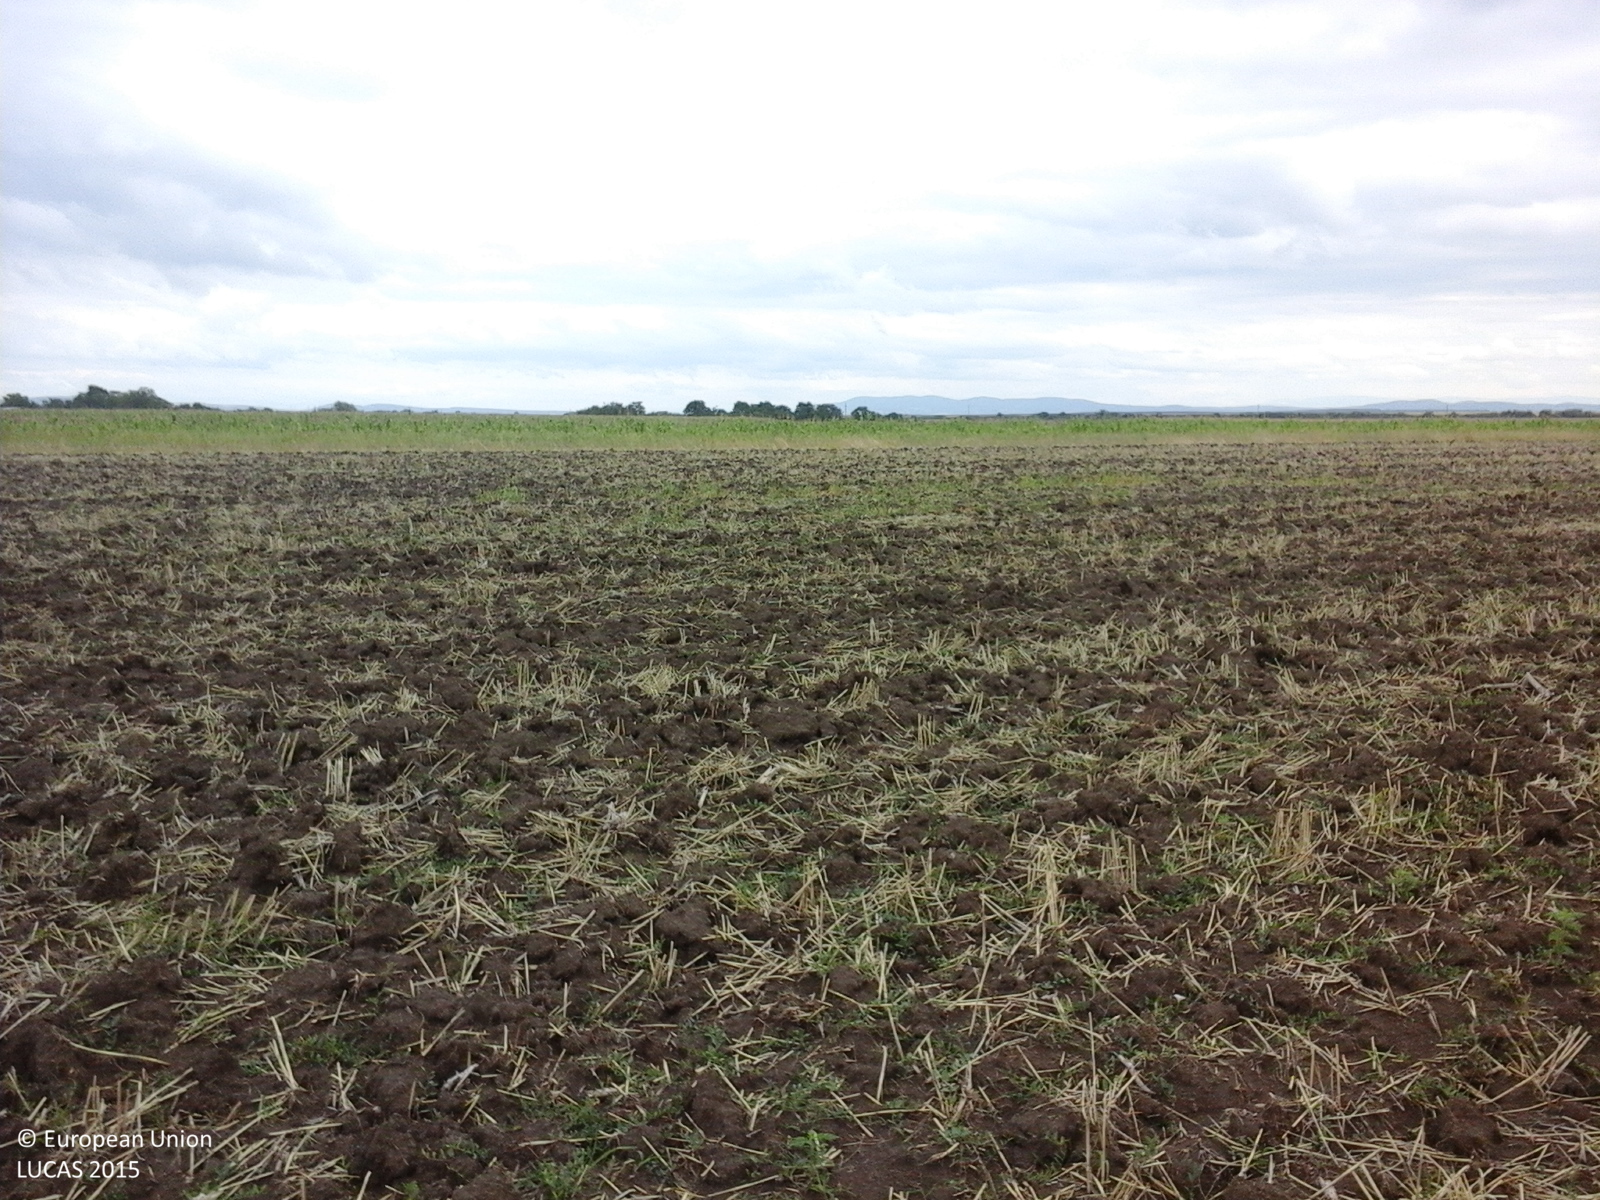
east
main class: Cropland
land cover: Common wheat
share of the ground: 10 - 25 %
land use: Agriculture (excluding fallow land and kitchen gardens)
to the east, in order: Common wheat; Oats; Maize; Spontaneously vegetated surfaces; Common wheat
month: August
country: RO
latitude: 45.5117
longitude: 21.4885
